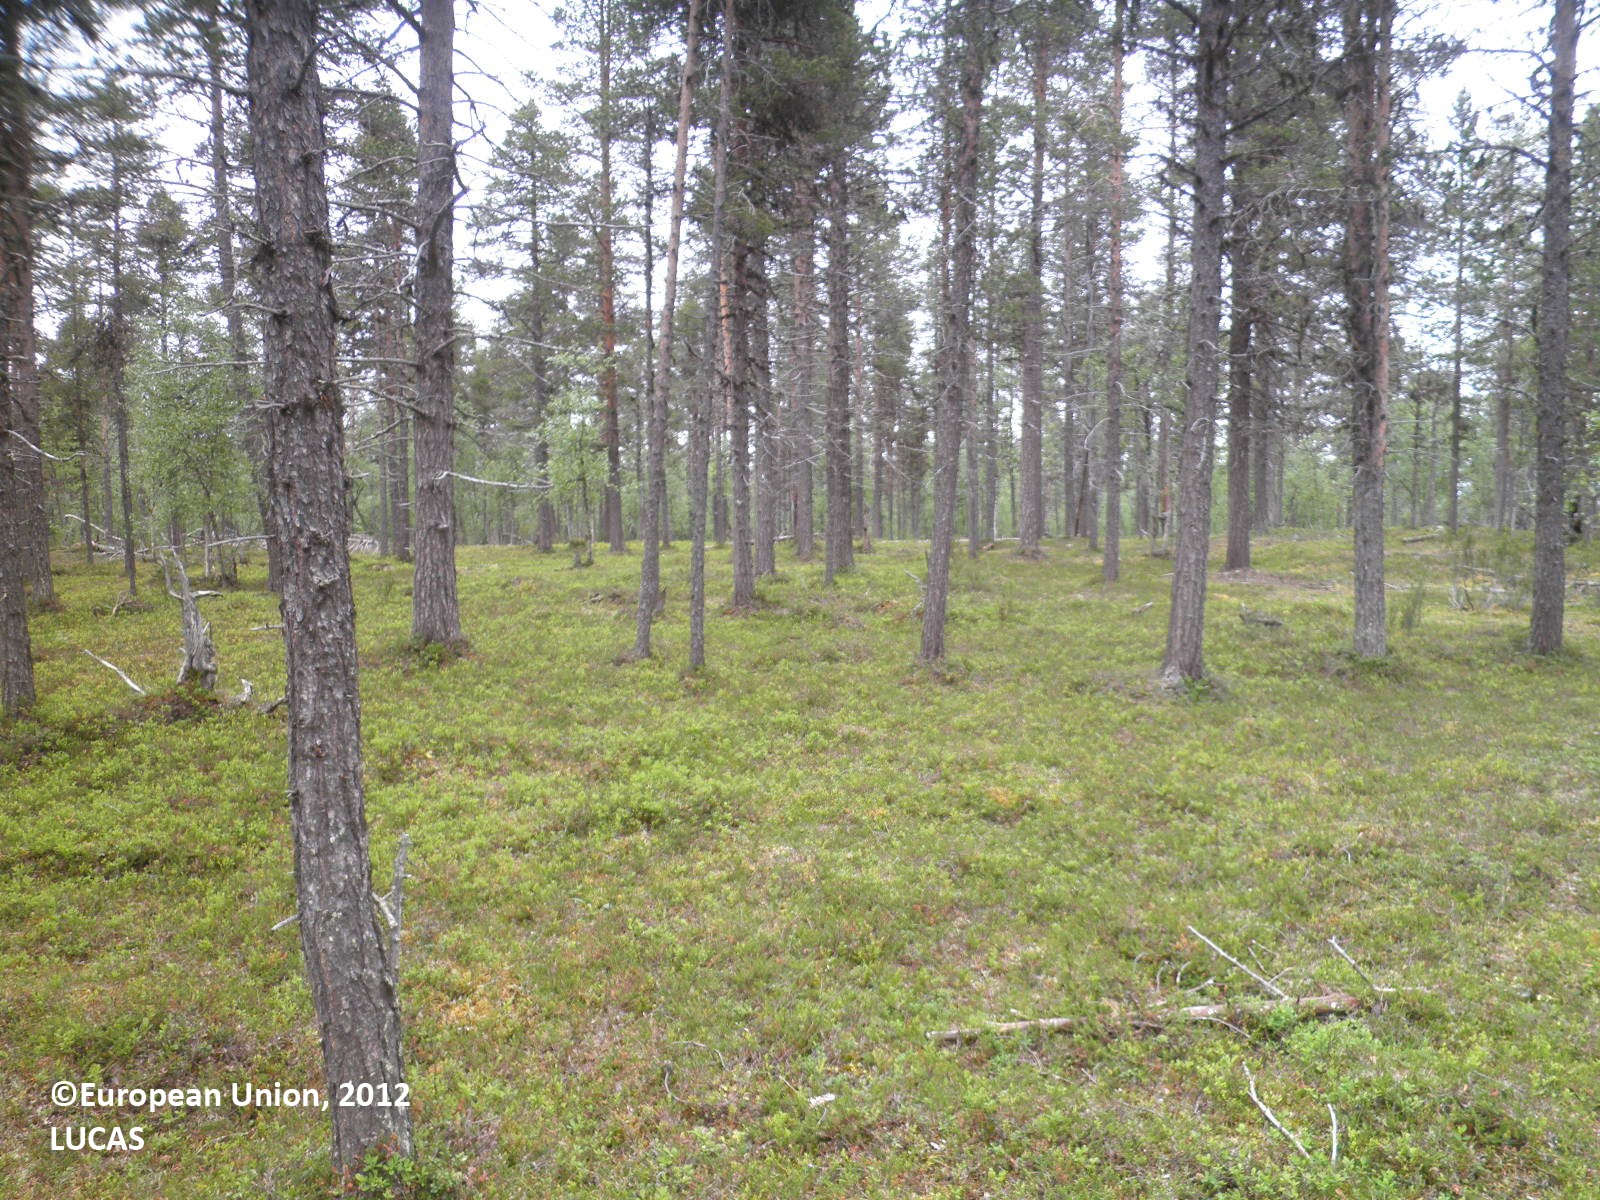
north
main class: Woodland
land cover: Pine dominated coniferous woodland
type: boreal forest
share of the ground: 25 - 50 %
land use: Forestry
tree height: > 5 m
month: July
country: FI
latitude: 68.4322
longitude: 25.9115
